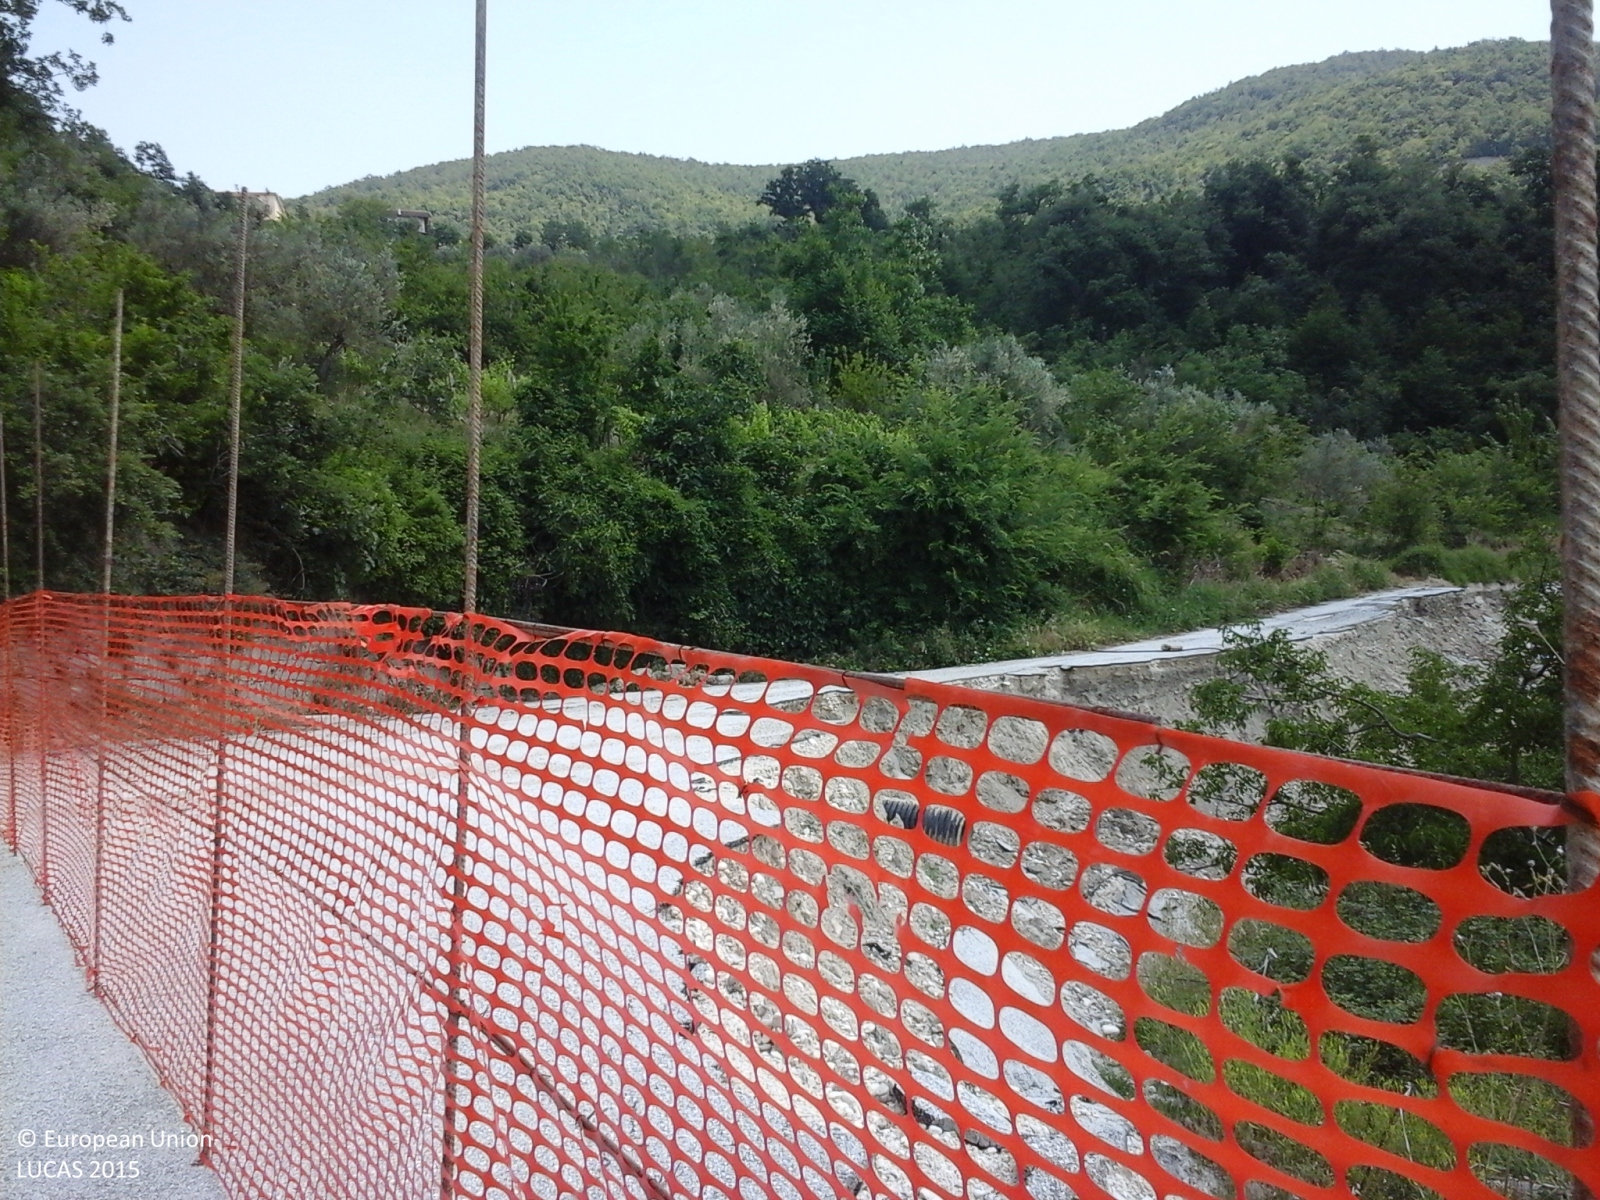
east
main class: Grassland
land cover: Grassland without tree/shrub cover
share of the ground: > 75 %
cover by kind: herbaceous plants 100 %
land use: Agriculture (excluding fallow land and kitchen gardens)
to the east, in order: Grassland without tree/shrub cover; Paved roads, cycling and walking lanes; Broadleaved woodland; Tracks; Broadleaved woodland
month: June
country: IT
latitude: 41.9800
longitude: 14.3910
